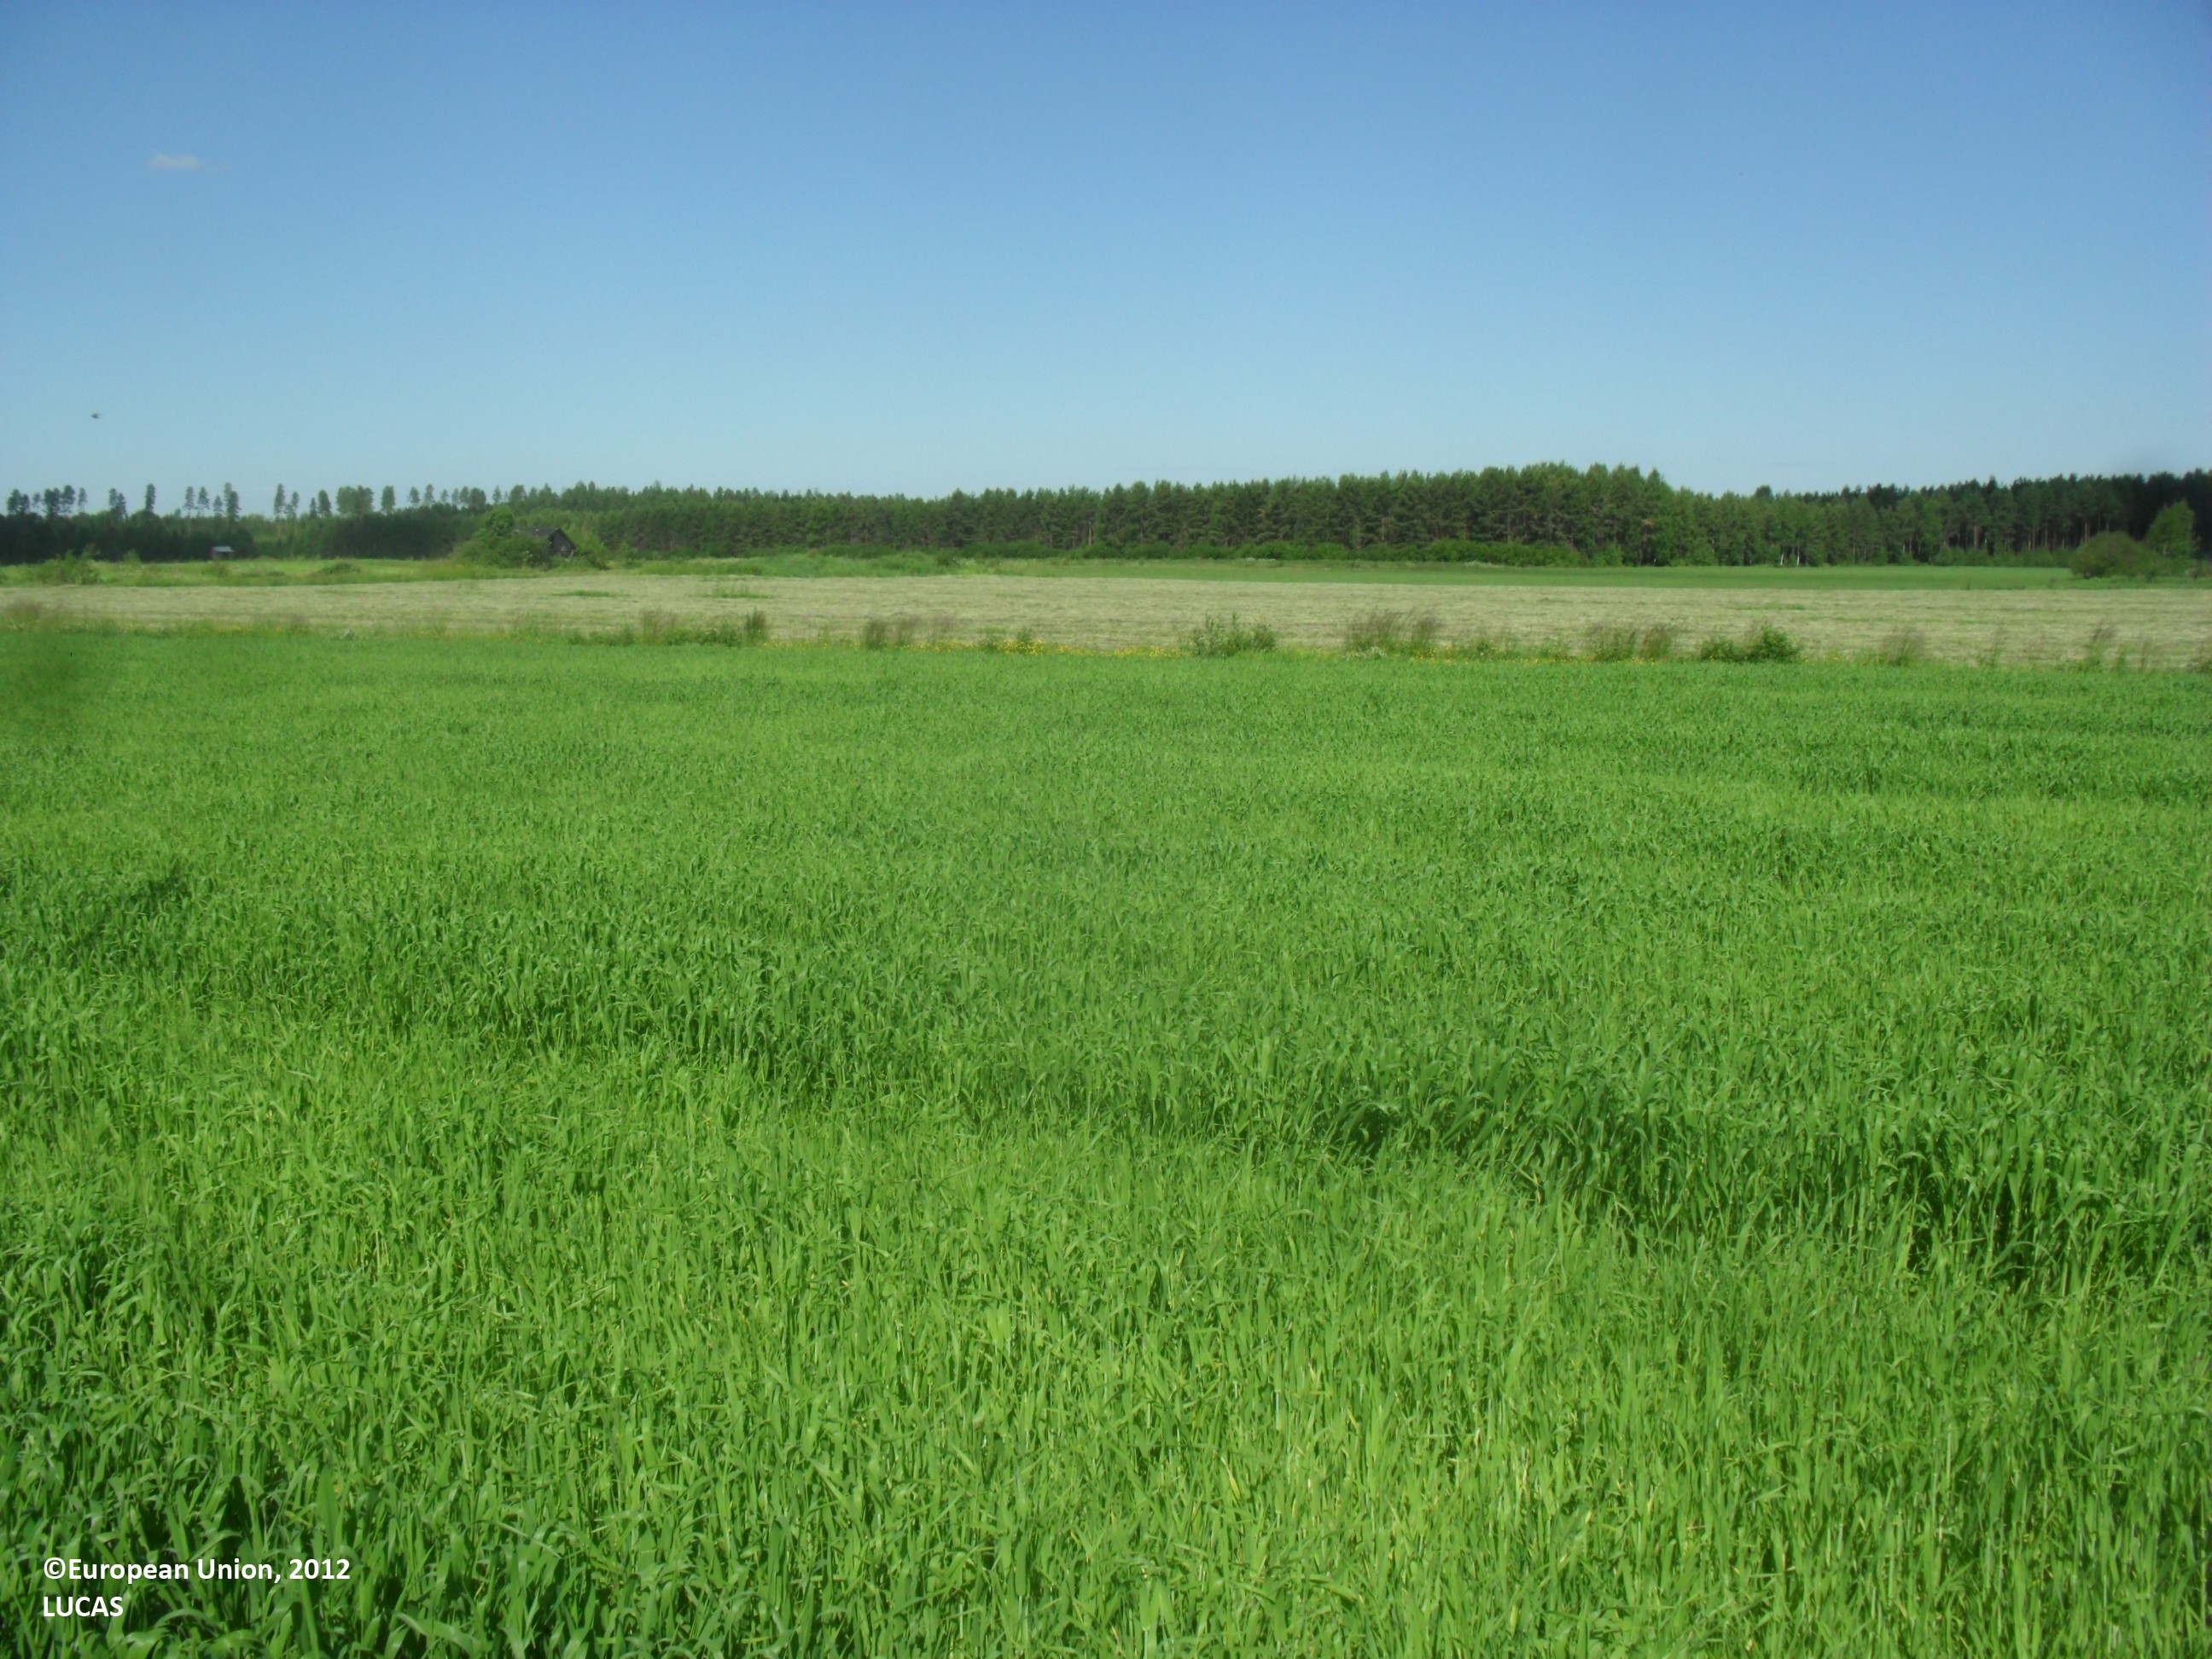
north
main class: Cropland
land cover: Oats
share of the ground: > 75 %
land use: Agriculture (excluding fallow land and kitchen gardens)
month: July
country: FI
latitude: 63.3047
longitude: 23.8972
